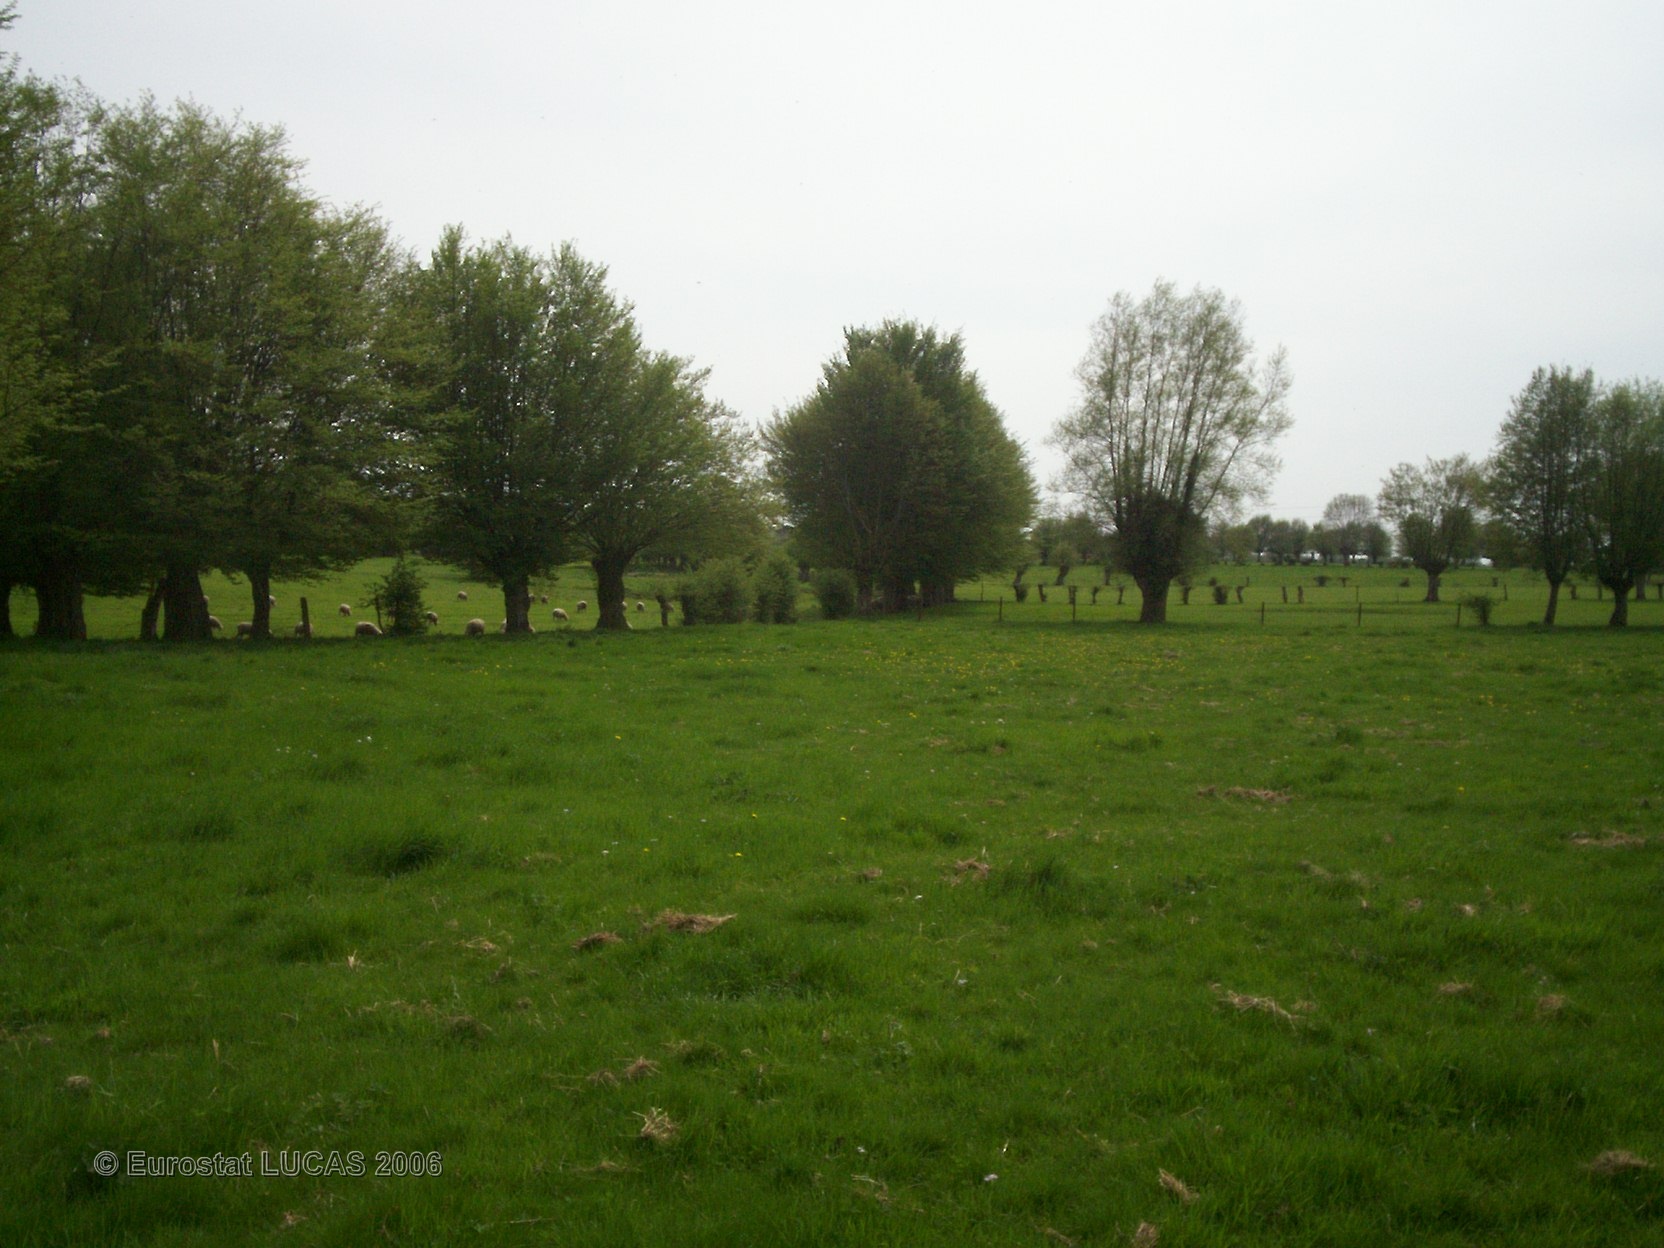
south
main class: Grassland
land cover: Grassland without tree/shrub cover
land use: Agriculture (excluding fallow land and kitchen gardens)
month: May
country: FR
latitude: 50.0310
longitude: 3.7533
